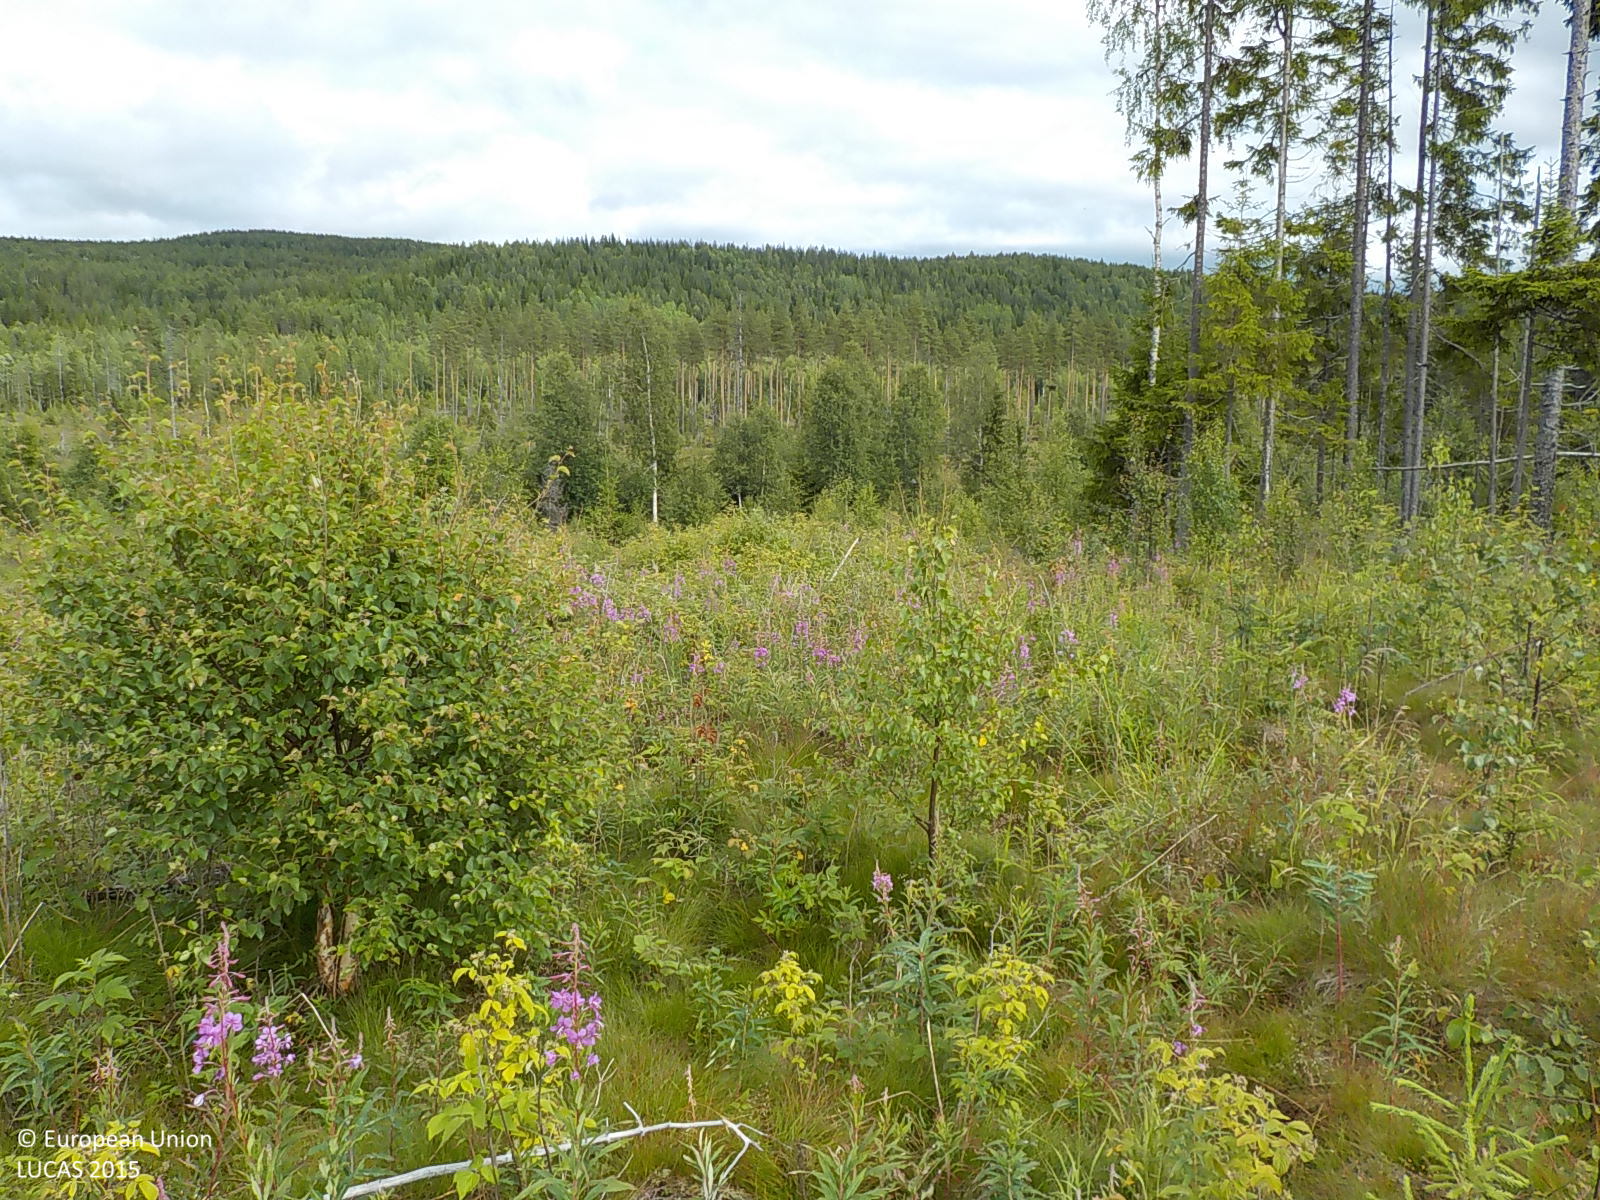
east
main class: Woodland
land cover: Broadleaved woodland
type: boreal forest
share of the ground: 50 - 75 %
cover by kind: broadleaved forest trees 60 %, shrubs 40 %
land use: Forestry
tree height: < 5 m
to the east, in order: Broadleaved woodland; Other mixed woodland; Broadleaved woodland; Paved roads, cycling and walking lanes; Broadleaved woodland; Rivers and streams; Broadleaved woodland; Pine dominated coniferous woodland
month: July
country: SE
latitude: 63.2263
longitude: 16.6410
